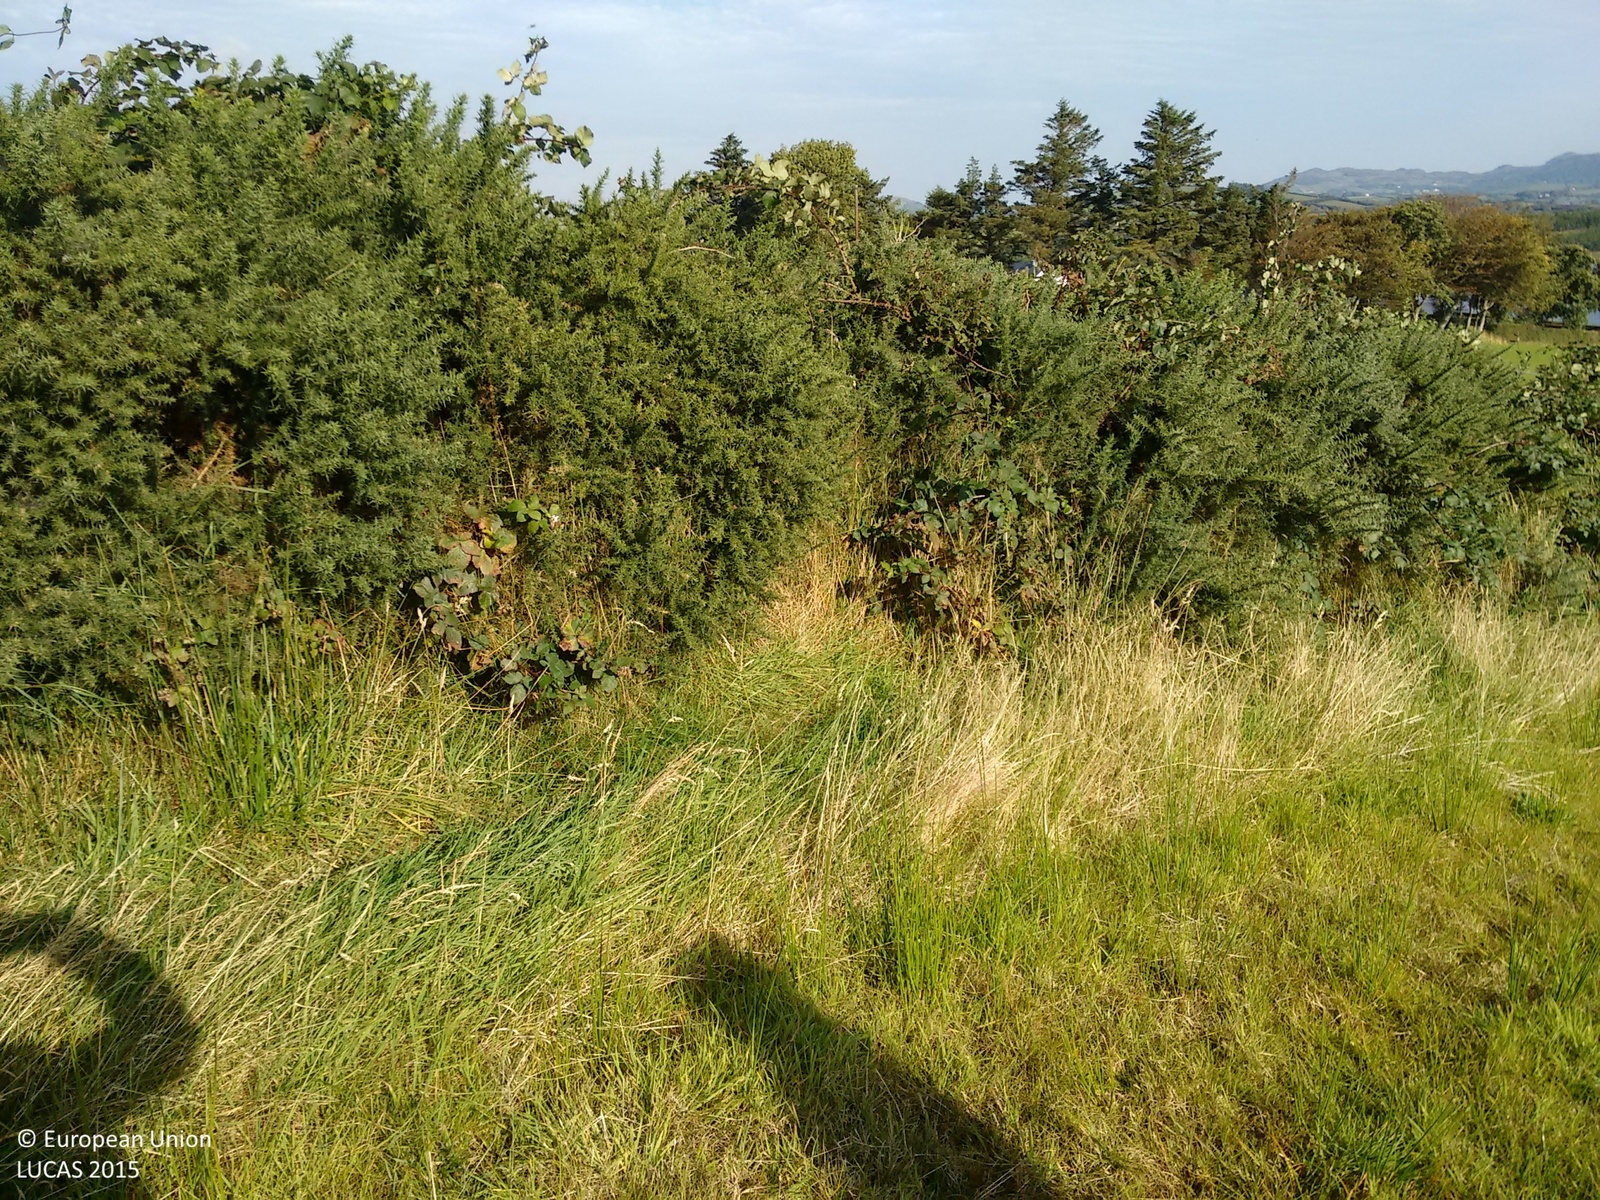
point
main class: Grassland
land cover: Grassland without tree/shrub cover
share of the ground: > 75 %
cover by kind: herbaceous plants 100 %
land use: Agriculture (excluding fallow land and kitchen gardens)
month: September
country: IE
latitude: 55.1598
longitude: -7.7243
